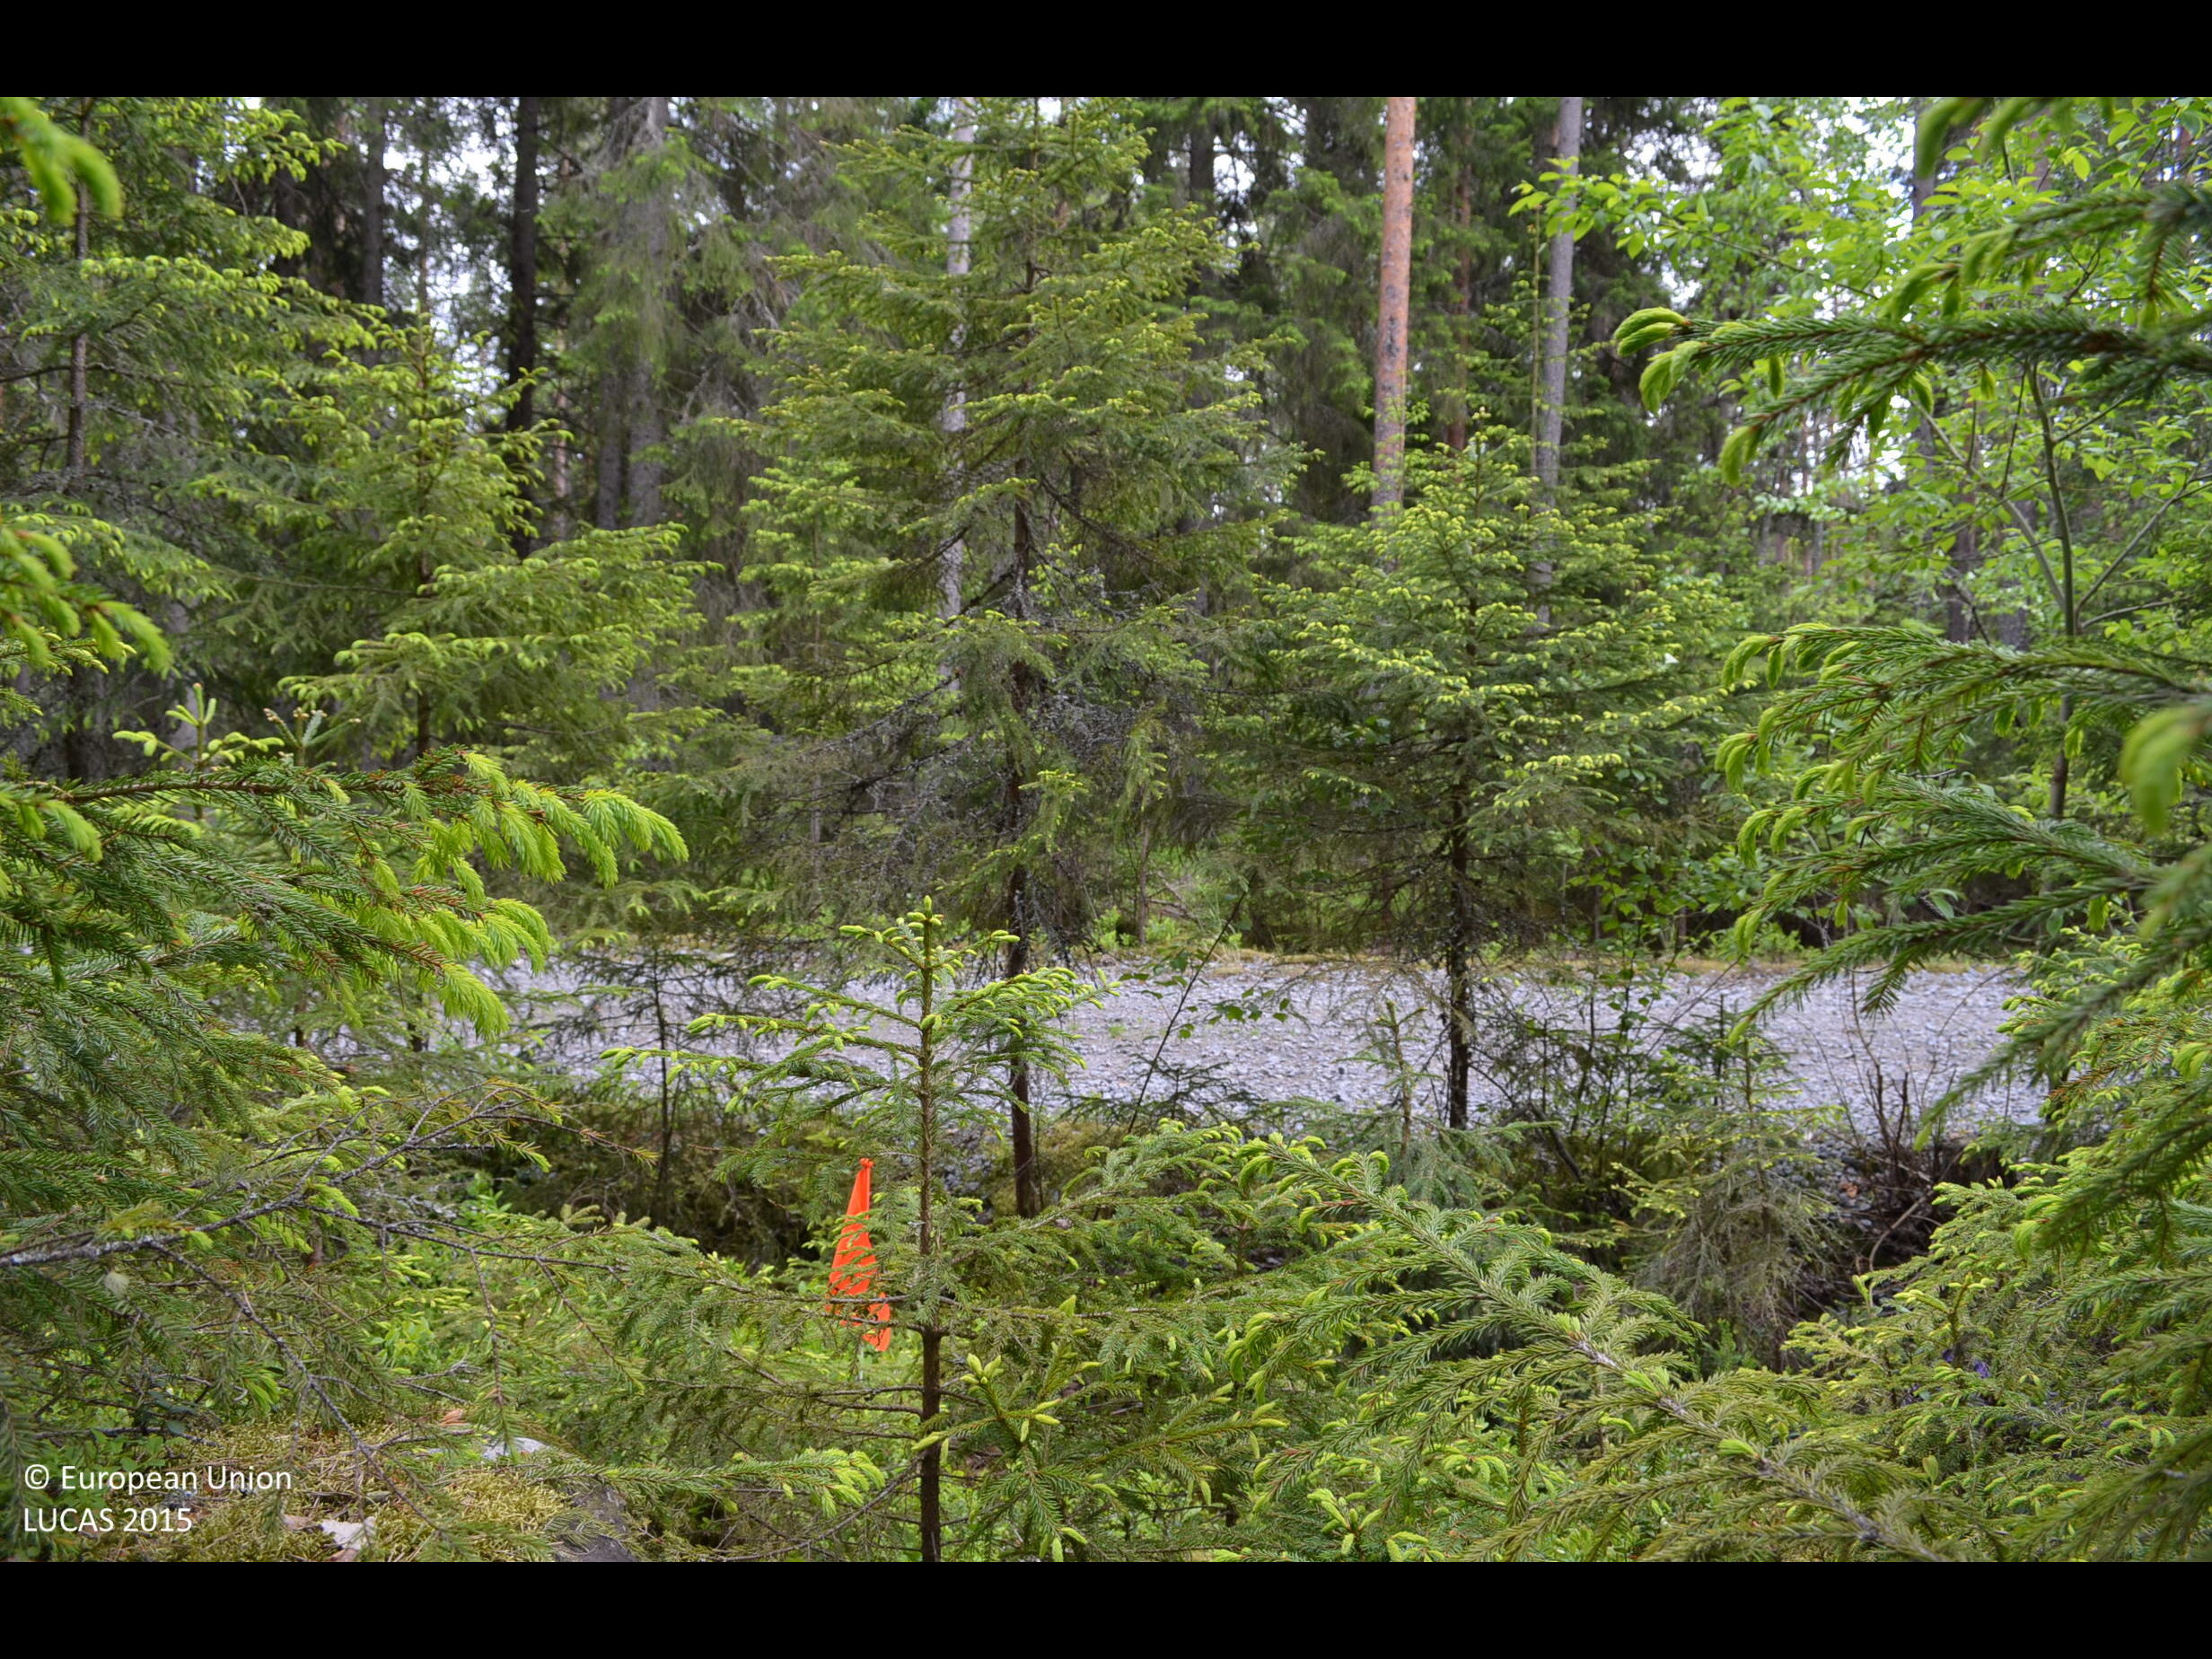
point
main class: Woodland
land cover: Other coniferous woodland
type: boreal forest
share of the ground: > 75 %
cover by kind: coniferous forest trees 65 %, shrubs 20 %, broadleaved forest trees 15 %
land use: Community services
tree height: > 5 m
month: June
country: FI
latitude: 61.9406
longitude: 23.3559
